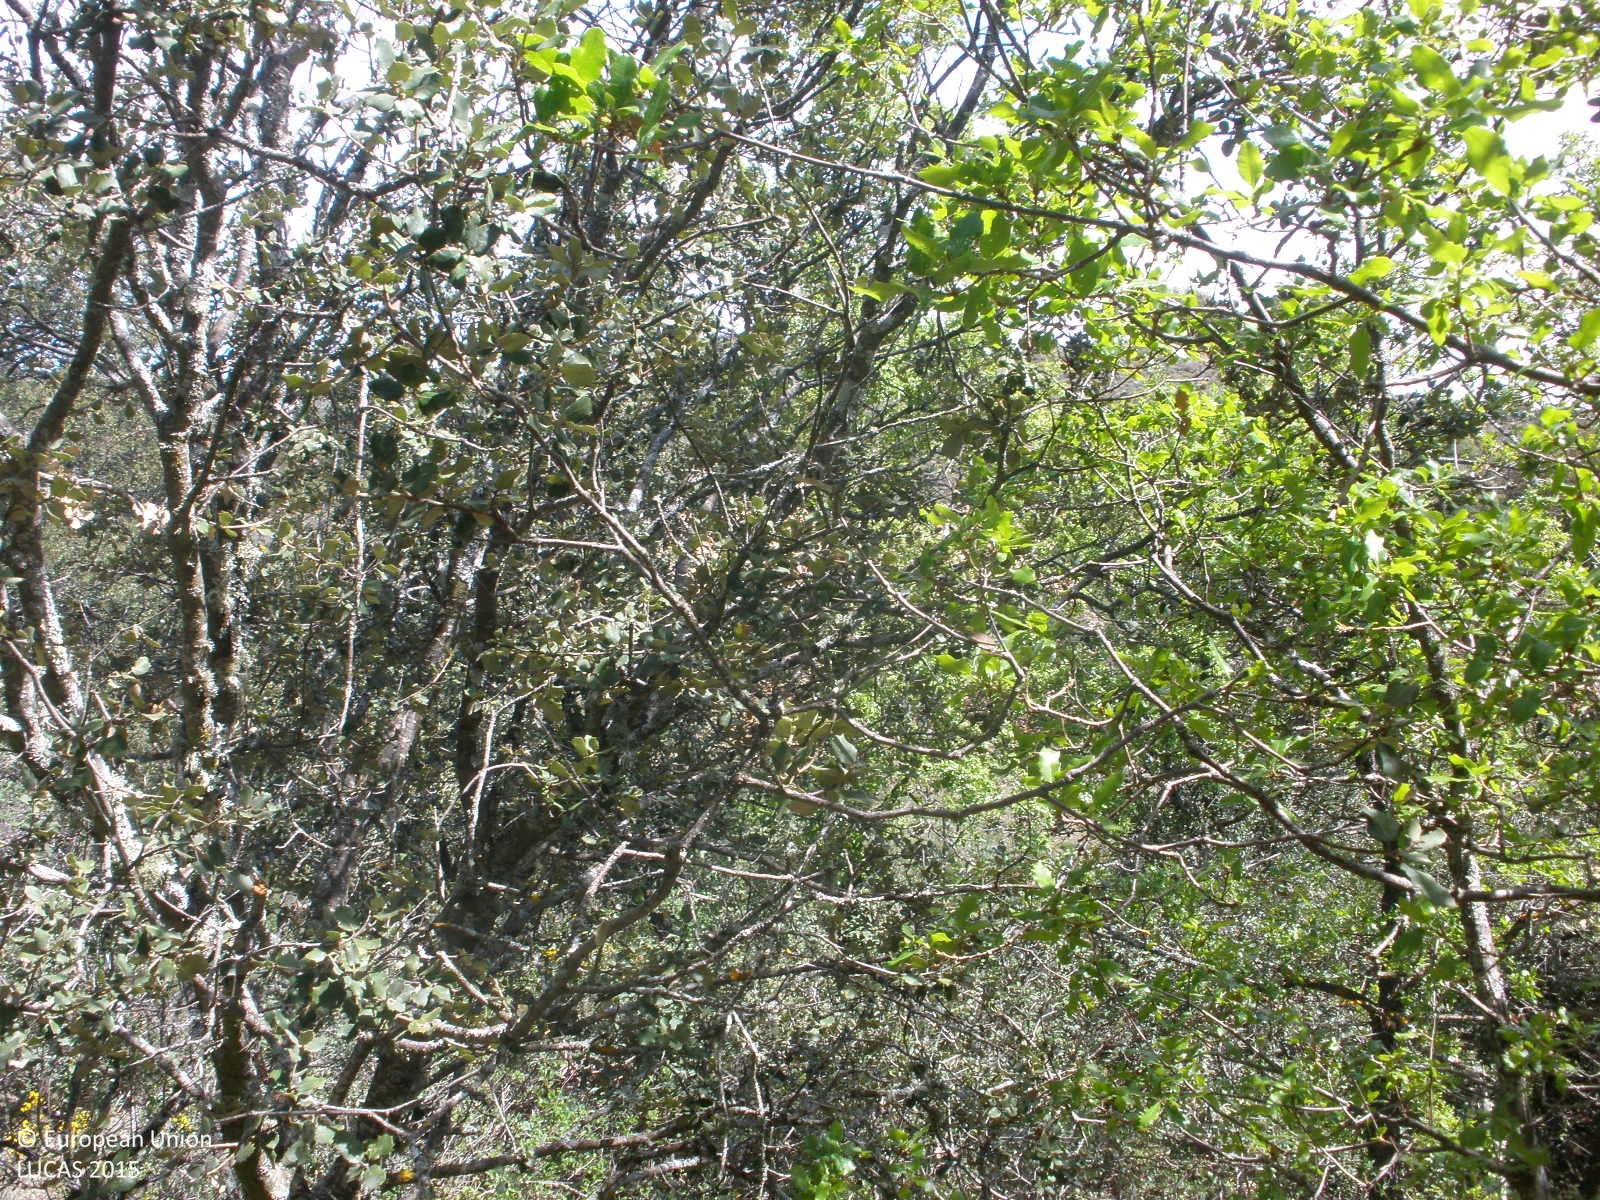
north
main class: Woodland
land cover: Broadleaved woodland
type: broadleaved evergreen forest
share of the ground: > 75 %
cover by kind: broadleaved forest trees 90 %, shrubs 5 %, herbaceous plants 5 %
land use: Semi-natural and natural areas not in use
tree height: < 5 m
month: May
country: ES
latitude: 40.9186
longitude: -0.8795
